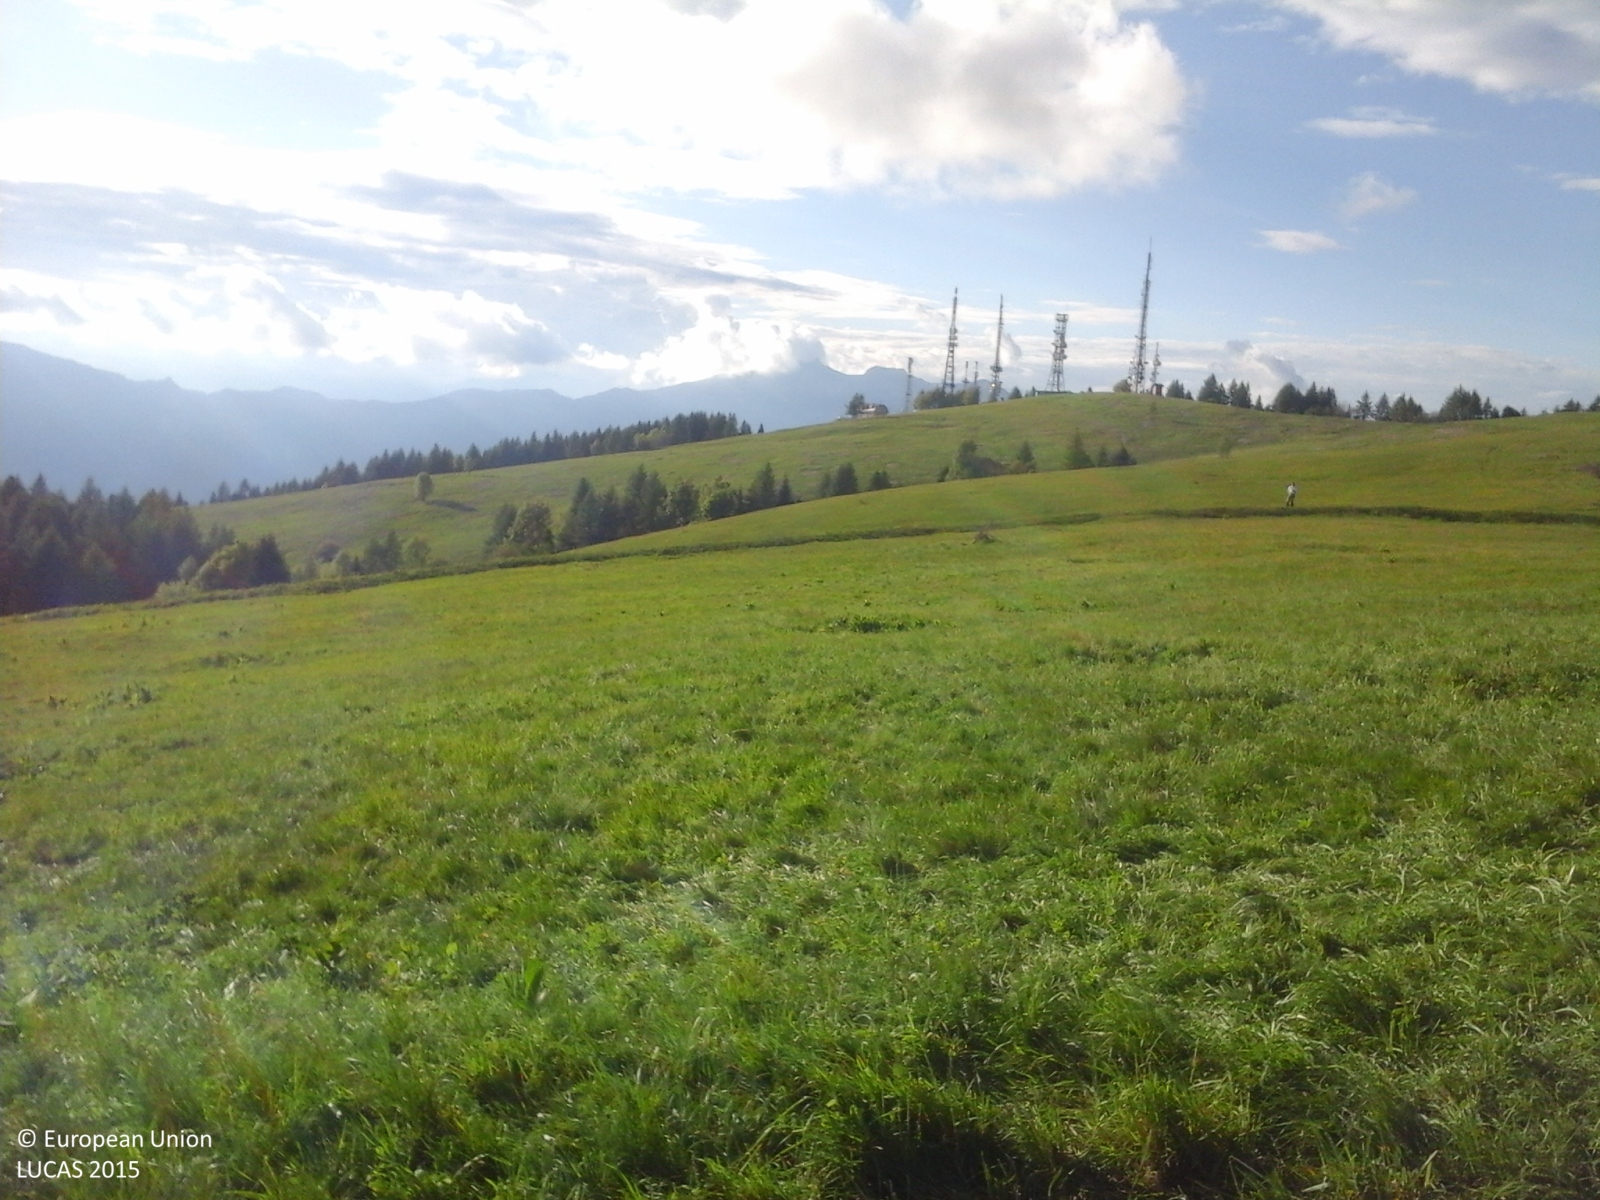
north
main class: Grassland
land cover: Grassland without tree/shrub cover
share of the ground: > 75 %
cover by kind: herbaceous plants 100 %
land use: Agriculture (excluding fallow land and kitchen gardens)
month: May
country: IT
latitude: 45.8949
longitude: 11.1196
